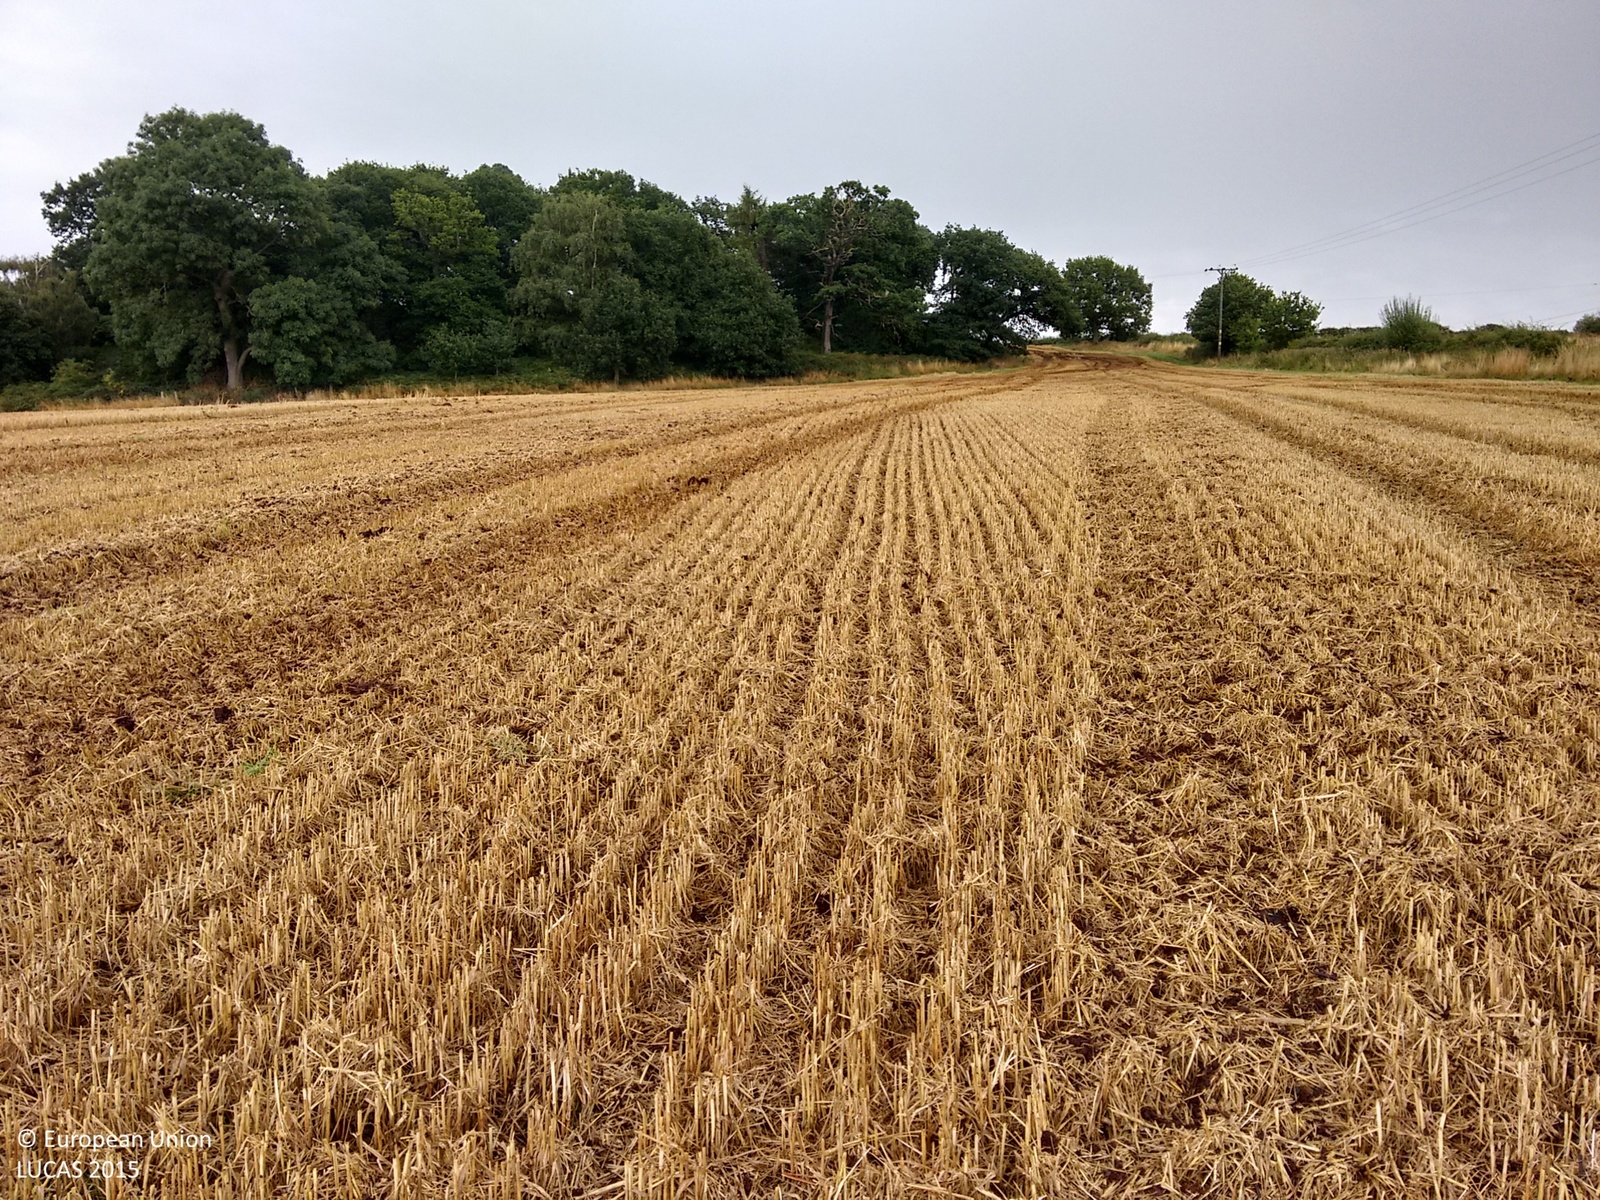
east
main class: Cropland
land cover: Common wheat
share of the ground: > 75 %
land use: Agriculture (excluding fallow land and kitchen gardens)
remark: Harvested field
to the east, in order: Common wheat; Grass margins; Fences; Broadleaved woodland; Fences; Common wheat; Electric lines; Common wheat; Grass margins; Managed hedges; Grass margins; Tracks; Grass margins; Common wheat
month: September
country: GB
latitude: 52.8371
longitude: -1.4658
